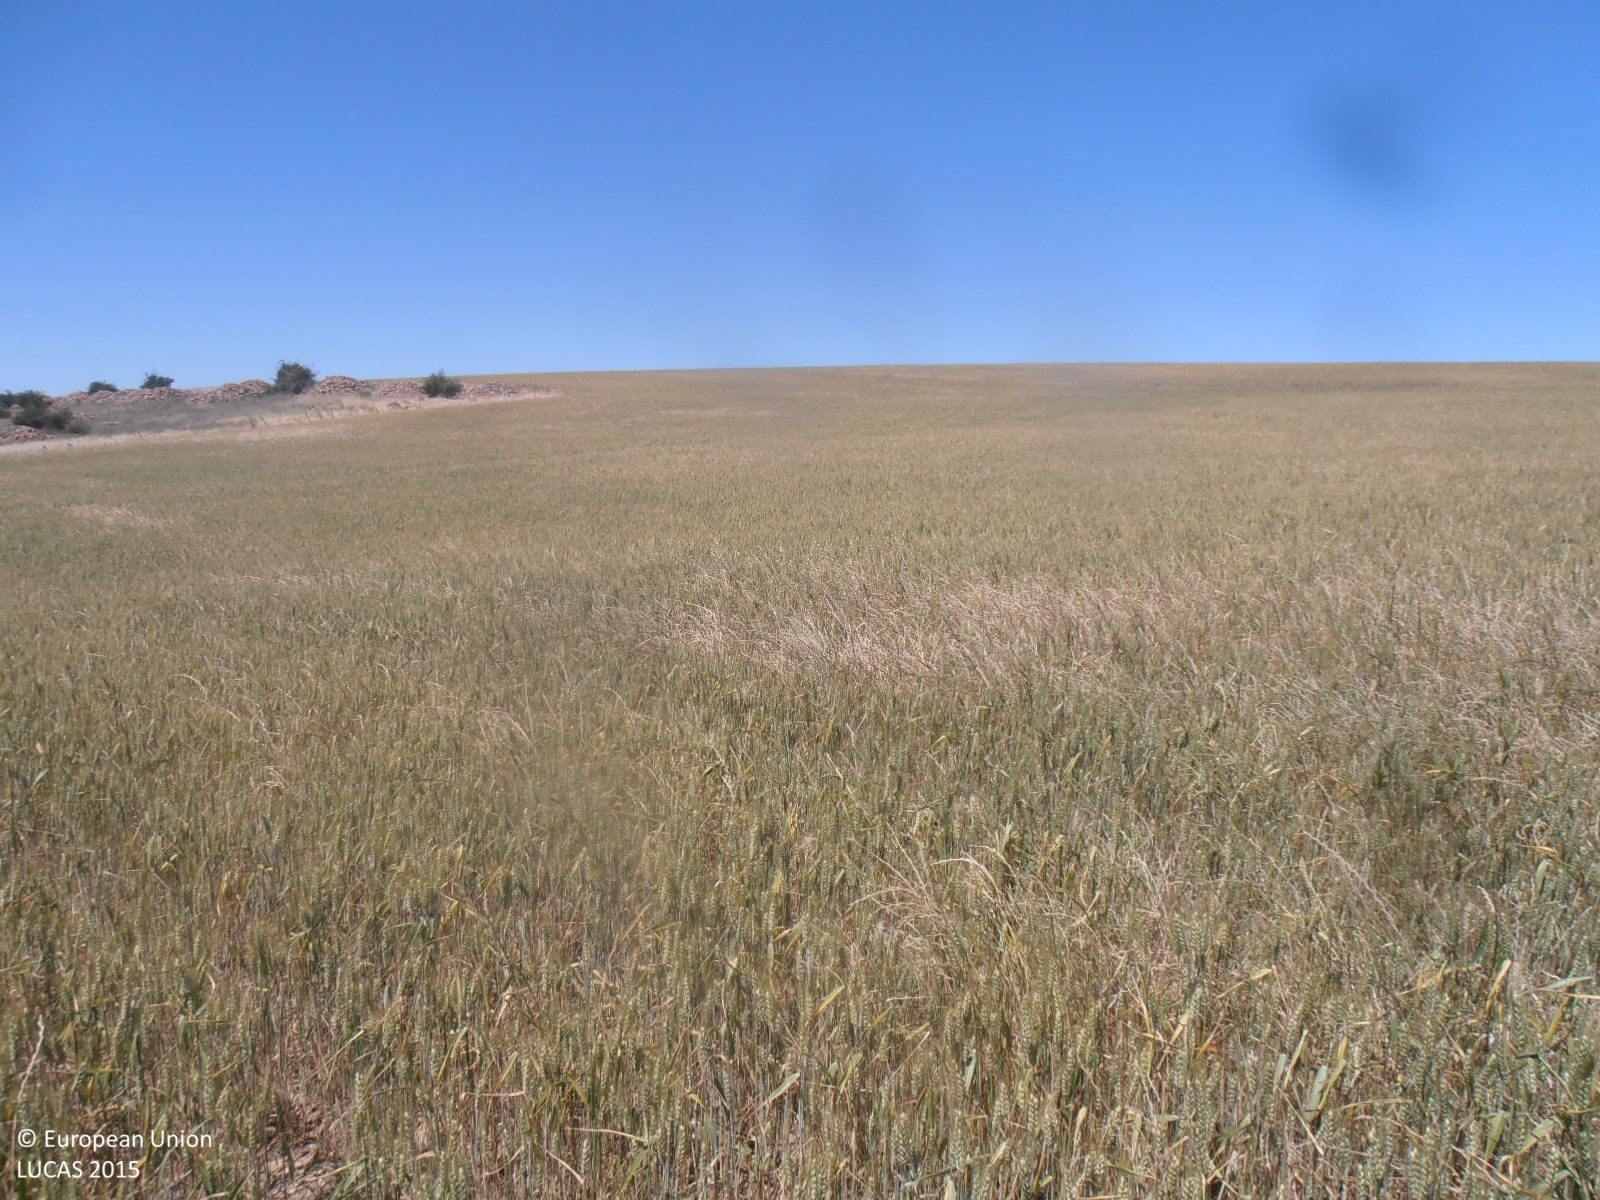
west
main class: Cropland
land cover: Common wheat
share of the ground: > 75 %
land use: Agriculture (excluding fallow land and kitchen gardens)
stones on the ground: 10 - 25 %
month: June
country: ES
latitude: 41.6871
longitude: -1.9617
